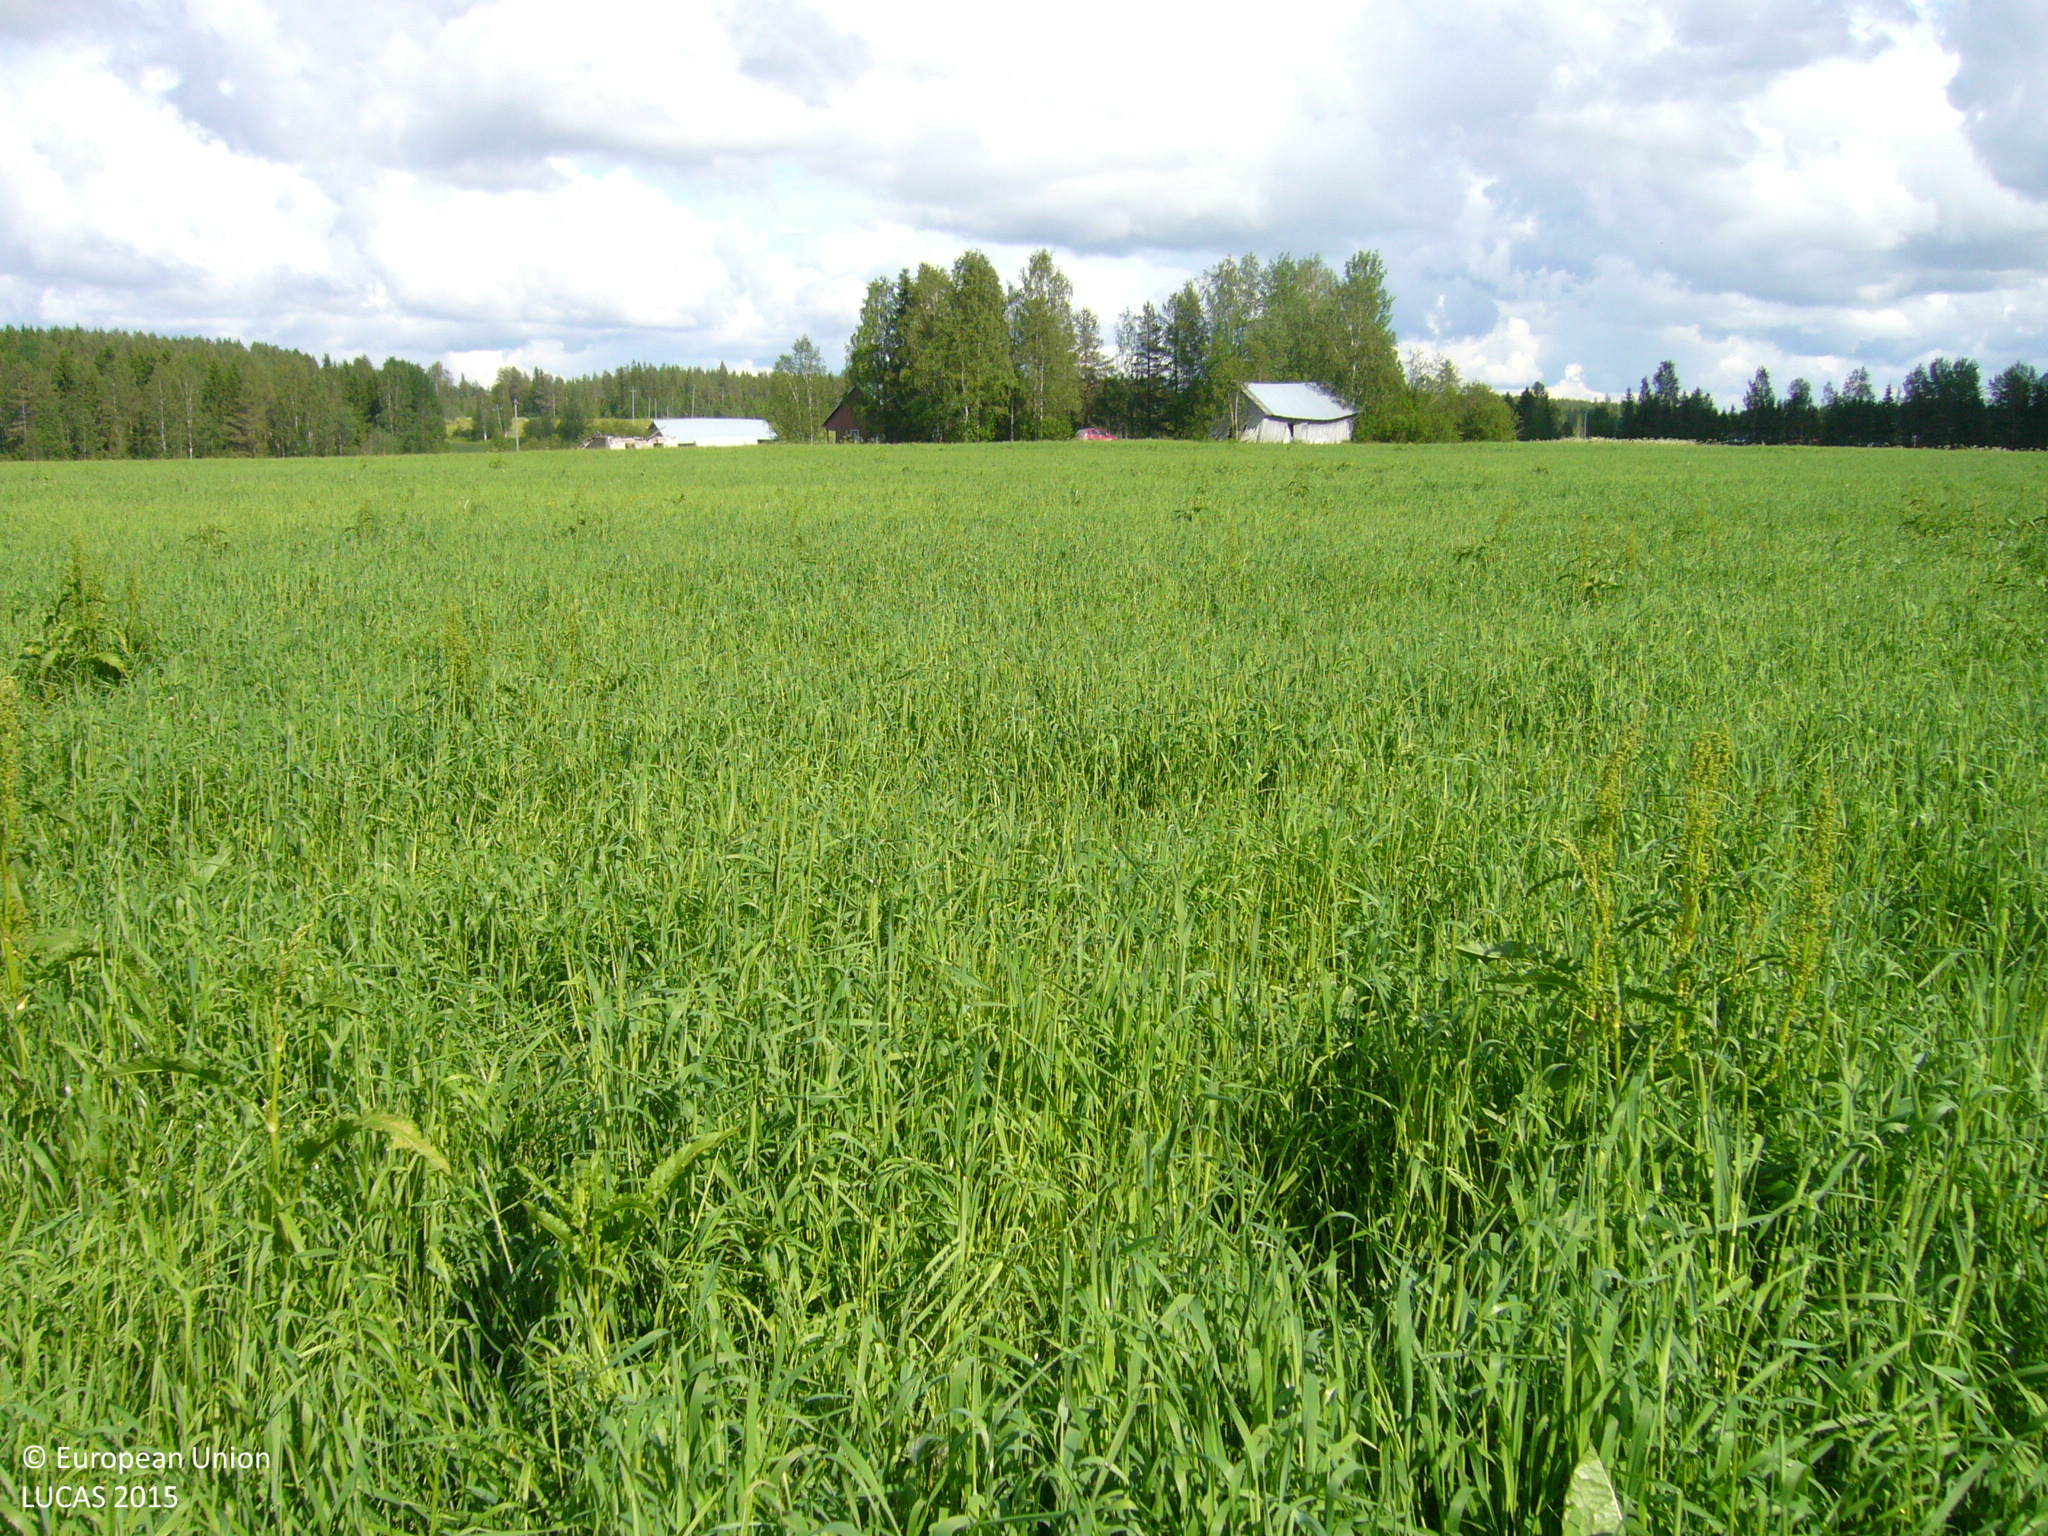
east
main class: Cropland
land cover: Temporary grasslands
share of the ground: > 75 %
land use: Agriculture (excluding fallow land and kitchen gardens)
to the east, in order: Temporary grasslands; Shruby margins; Ditches and canals; Grass margins; Paved roads, cycling and walking lanes; Grass margins; Ditches and canals; Grass margins; Temporary grasslands; Artificial constructions in urban areas
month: June
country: FI
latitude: 63.7842
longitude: 26.3302
